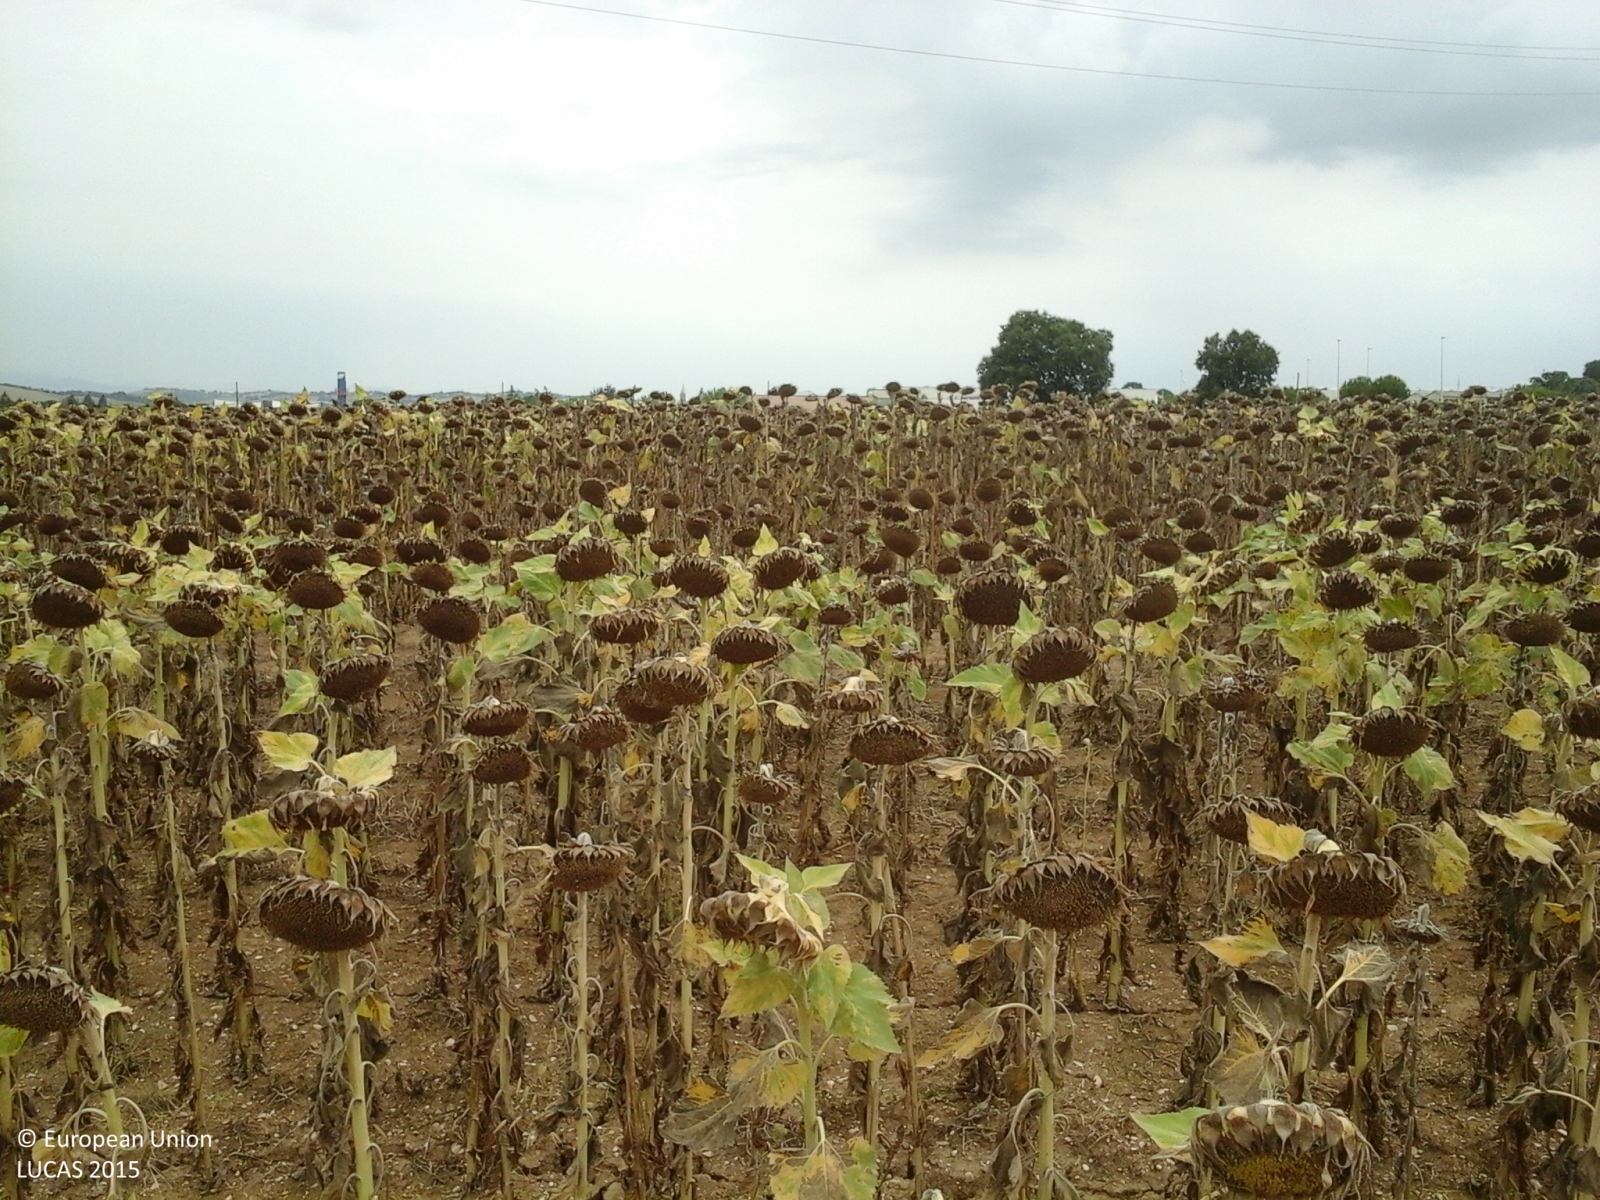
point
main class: Cropland
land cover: Sunflower
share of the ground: > 75 %
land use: Agriculture (excluding fallow land and kitchen gardens)
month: August
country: IT
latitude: 43.4604
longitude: 13.5138
